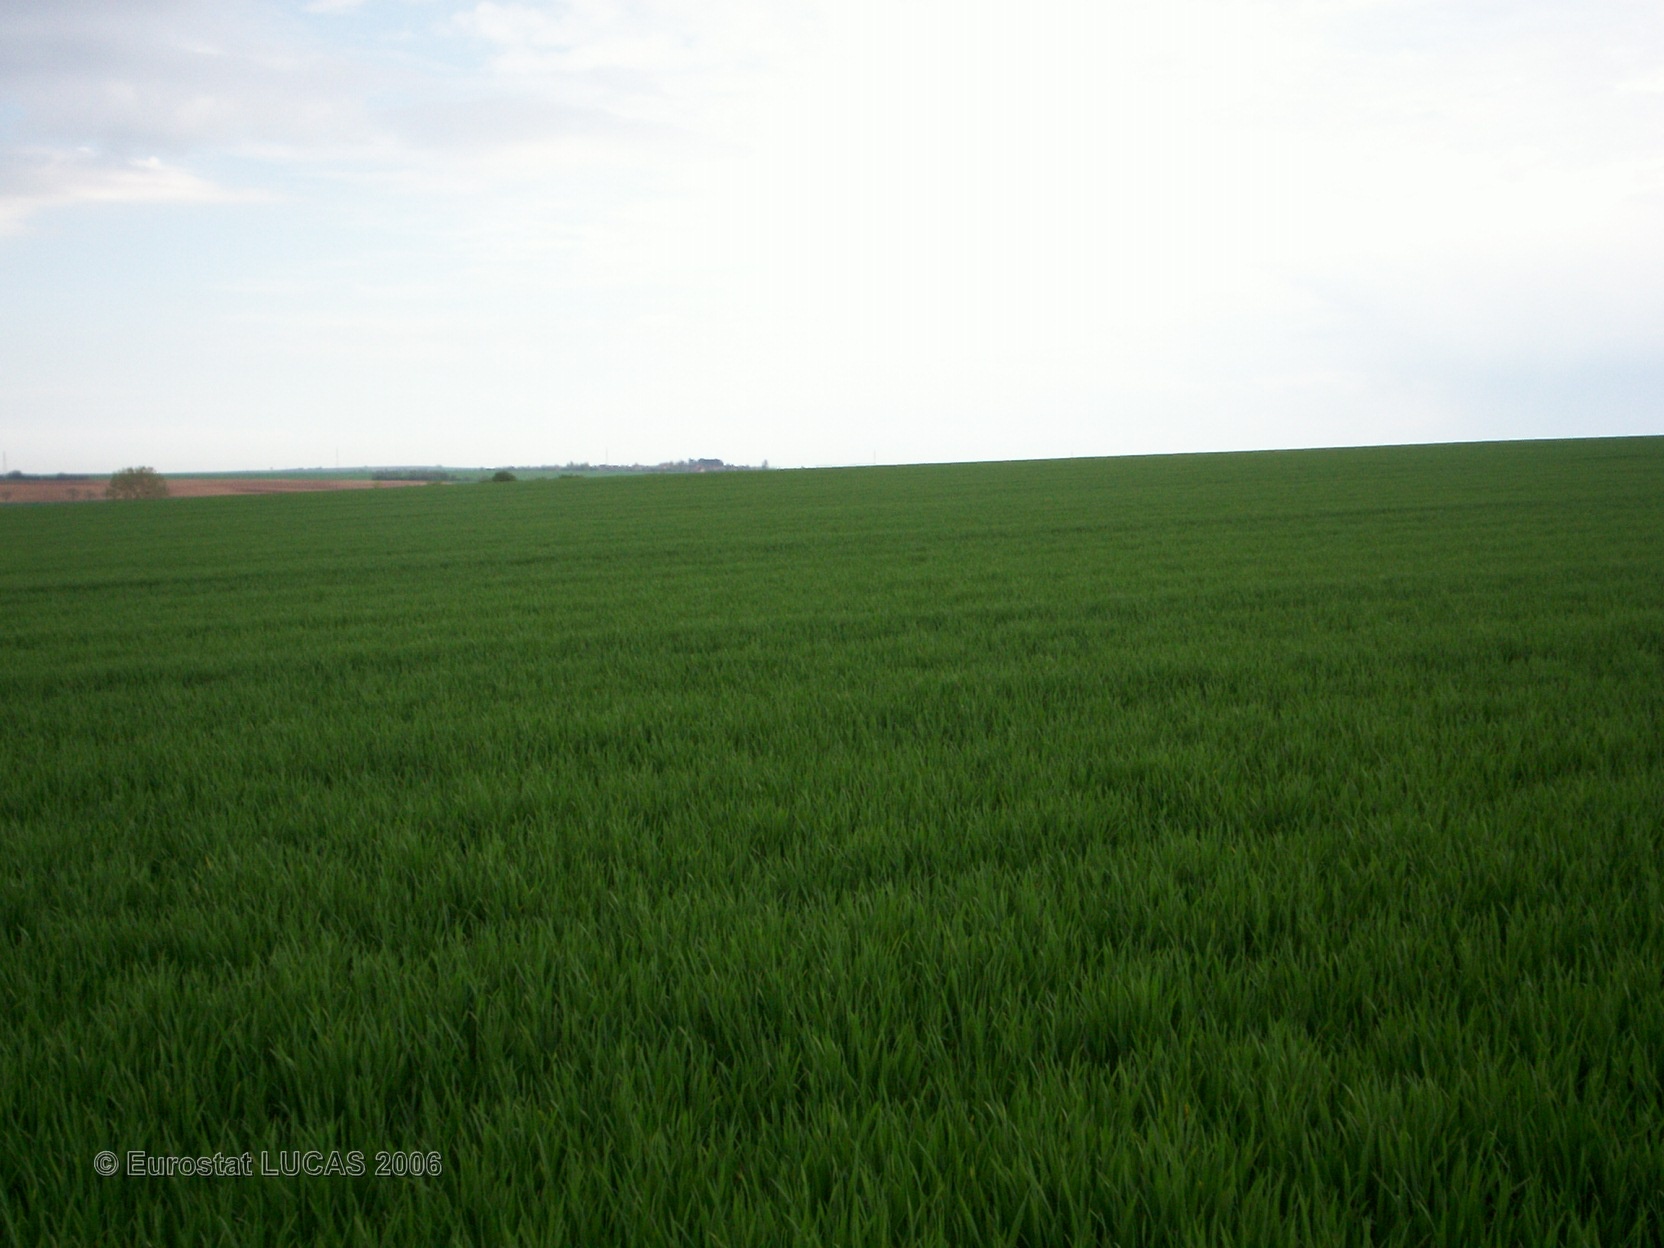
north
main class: Cropland
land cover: Common wheat
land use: Agriculture (excluding fallow land and kitchen gardens)
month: April
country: FR
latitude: 47.3535
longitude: 3.0446
